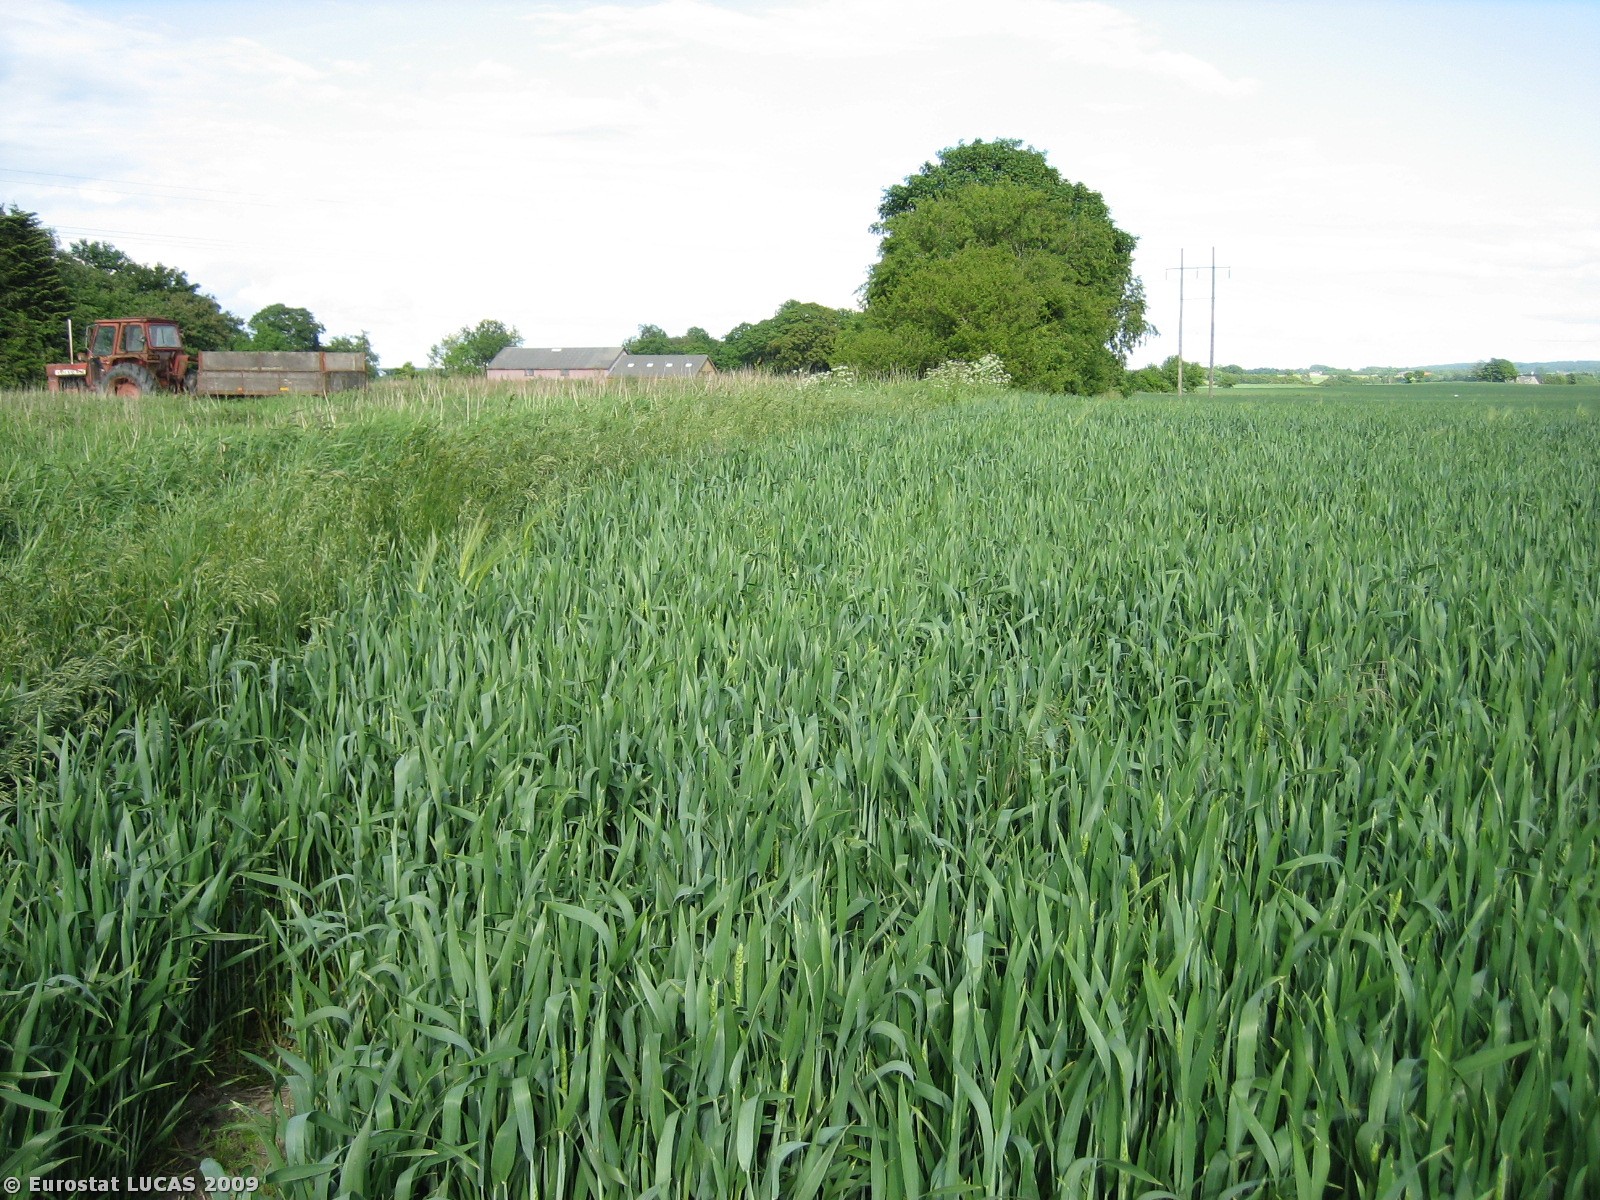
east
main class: Cropland
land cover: Common wheat
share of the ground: > 75 %
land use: Agriculture (excluding fallow land and kitchen gardens)
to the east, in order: Common wheat; Electric lines; Common wheat
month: June
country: DK
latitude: 56.2235
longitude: 9.7906
